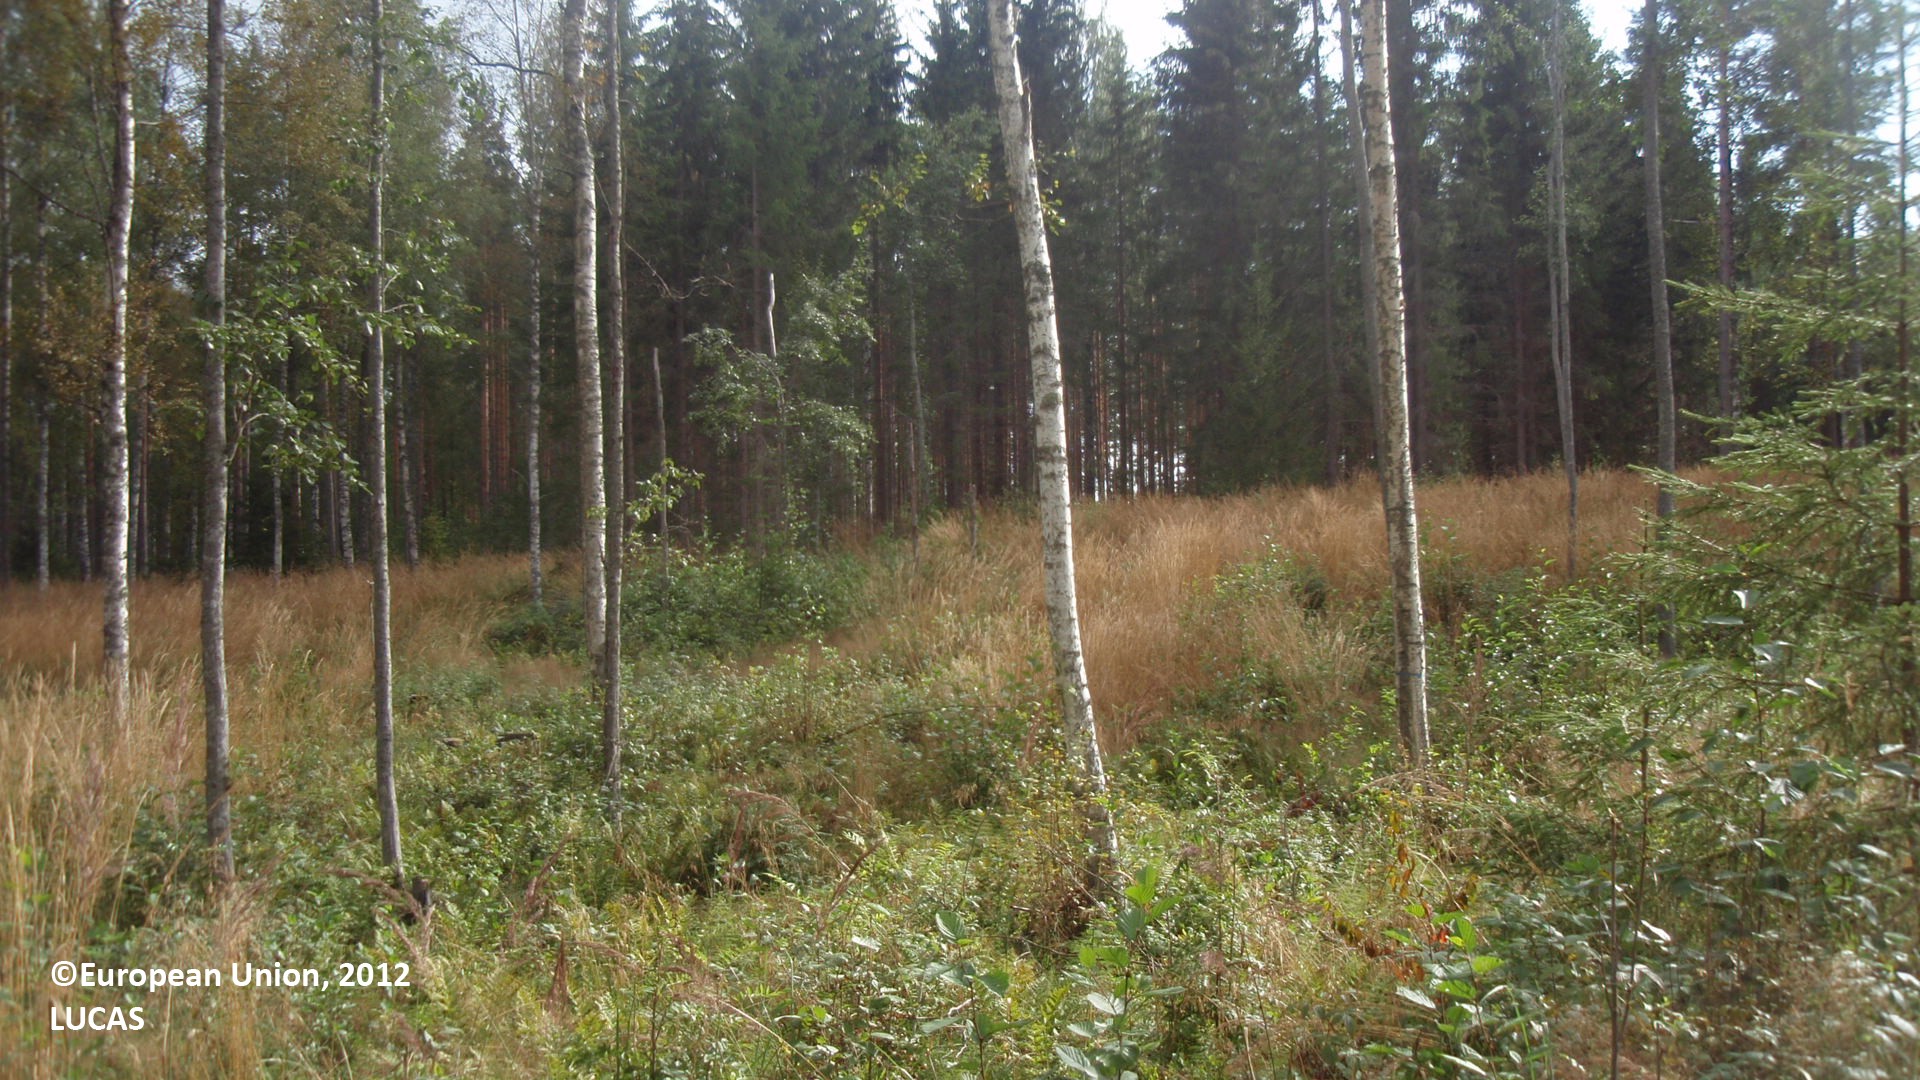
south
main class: Woodland
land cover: Broadleaved woodland
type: non-riverine alder, birch or aspen forest
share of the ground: 50 - 75 %
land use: Forestry
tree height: > 5 m
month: August
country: FI
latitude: 61.1540
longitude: 26.6739
